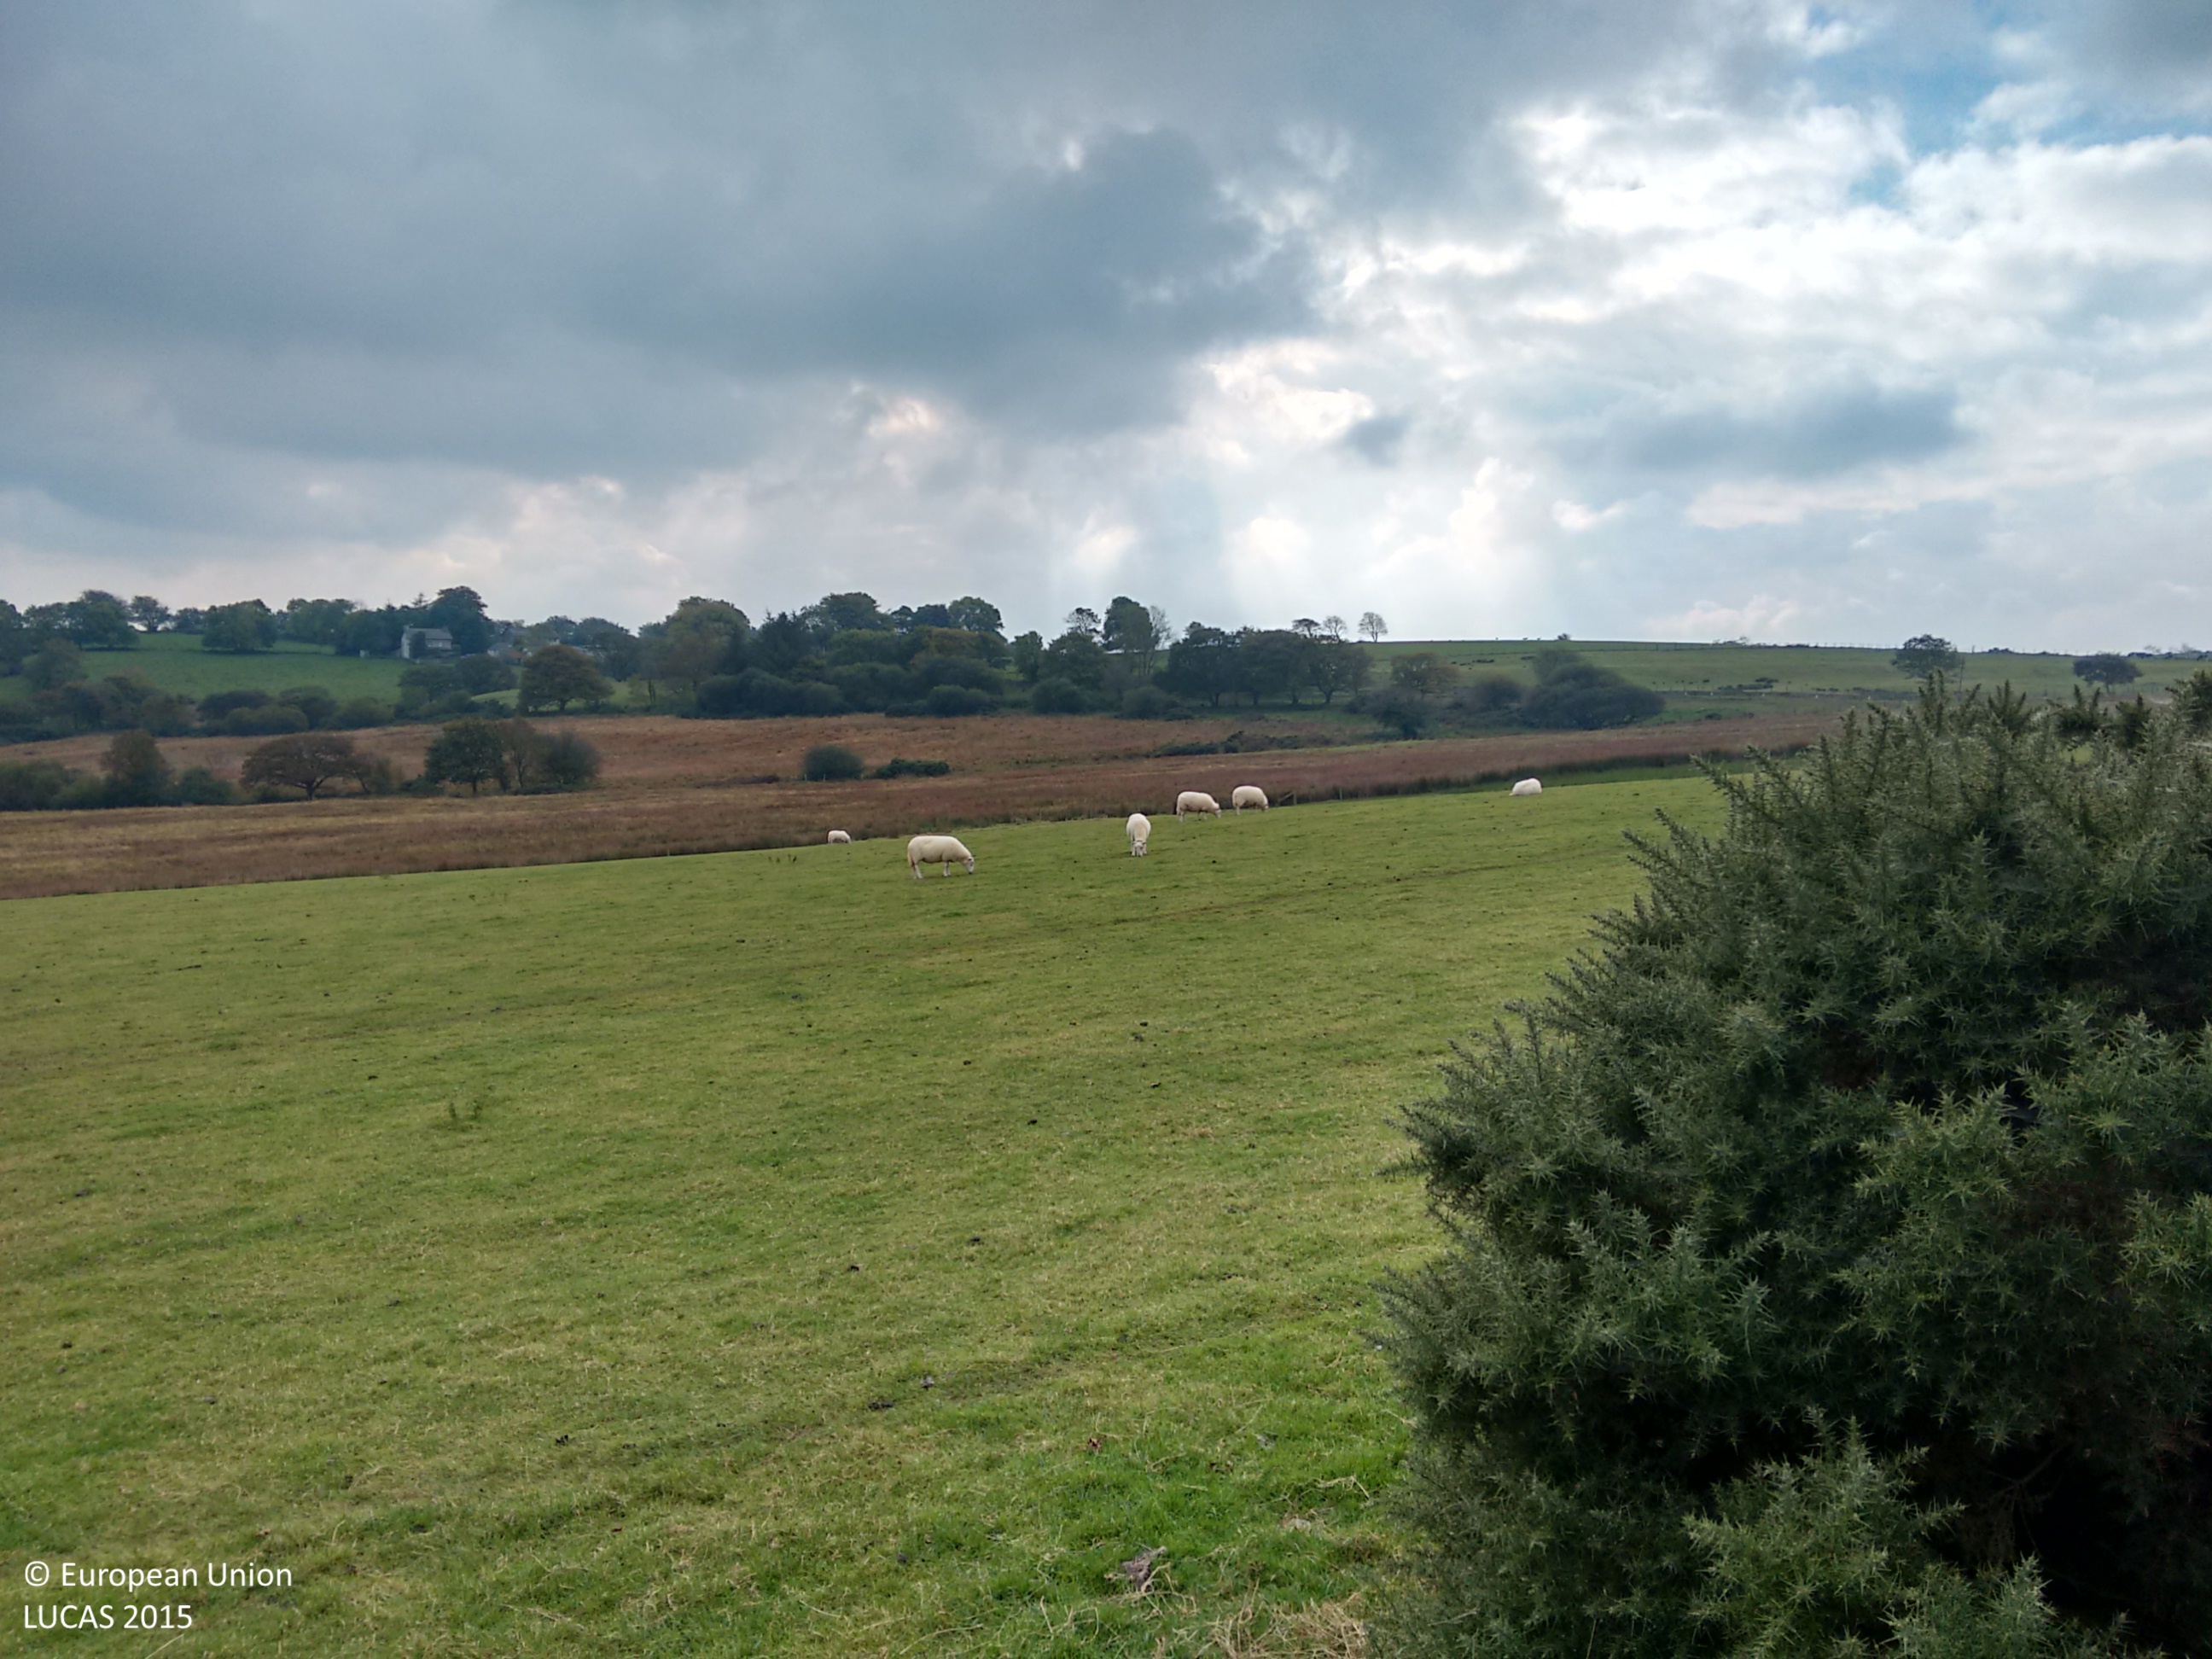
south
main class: Grassland
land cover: Grassland without tree/shrub cover
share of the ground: > 75 %
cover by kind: herbaceous plants 100 %
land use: Agriculture (excluding fallow land and kitchen gardens)
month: October
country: GB
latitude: 52.3003
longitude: -3.9214
